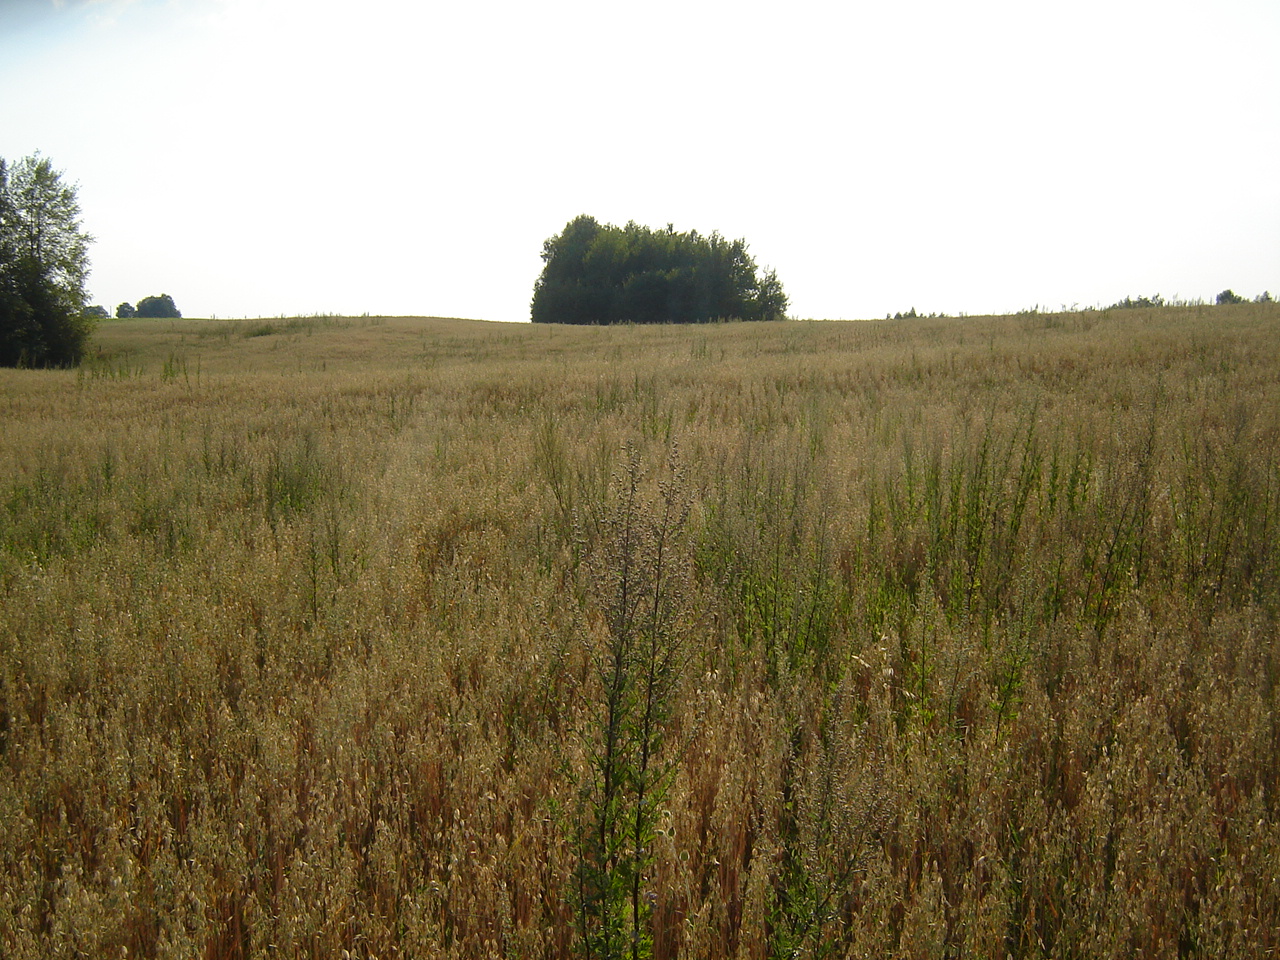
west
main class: Cropland
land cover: Oats
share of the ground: > 75 %
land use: Agriculture (excluding fallow land and kitchen gardens)
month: August
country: LT
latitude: 55.1977
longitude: 25.3771
